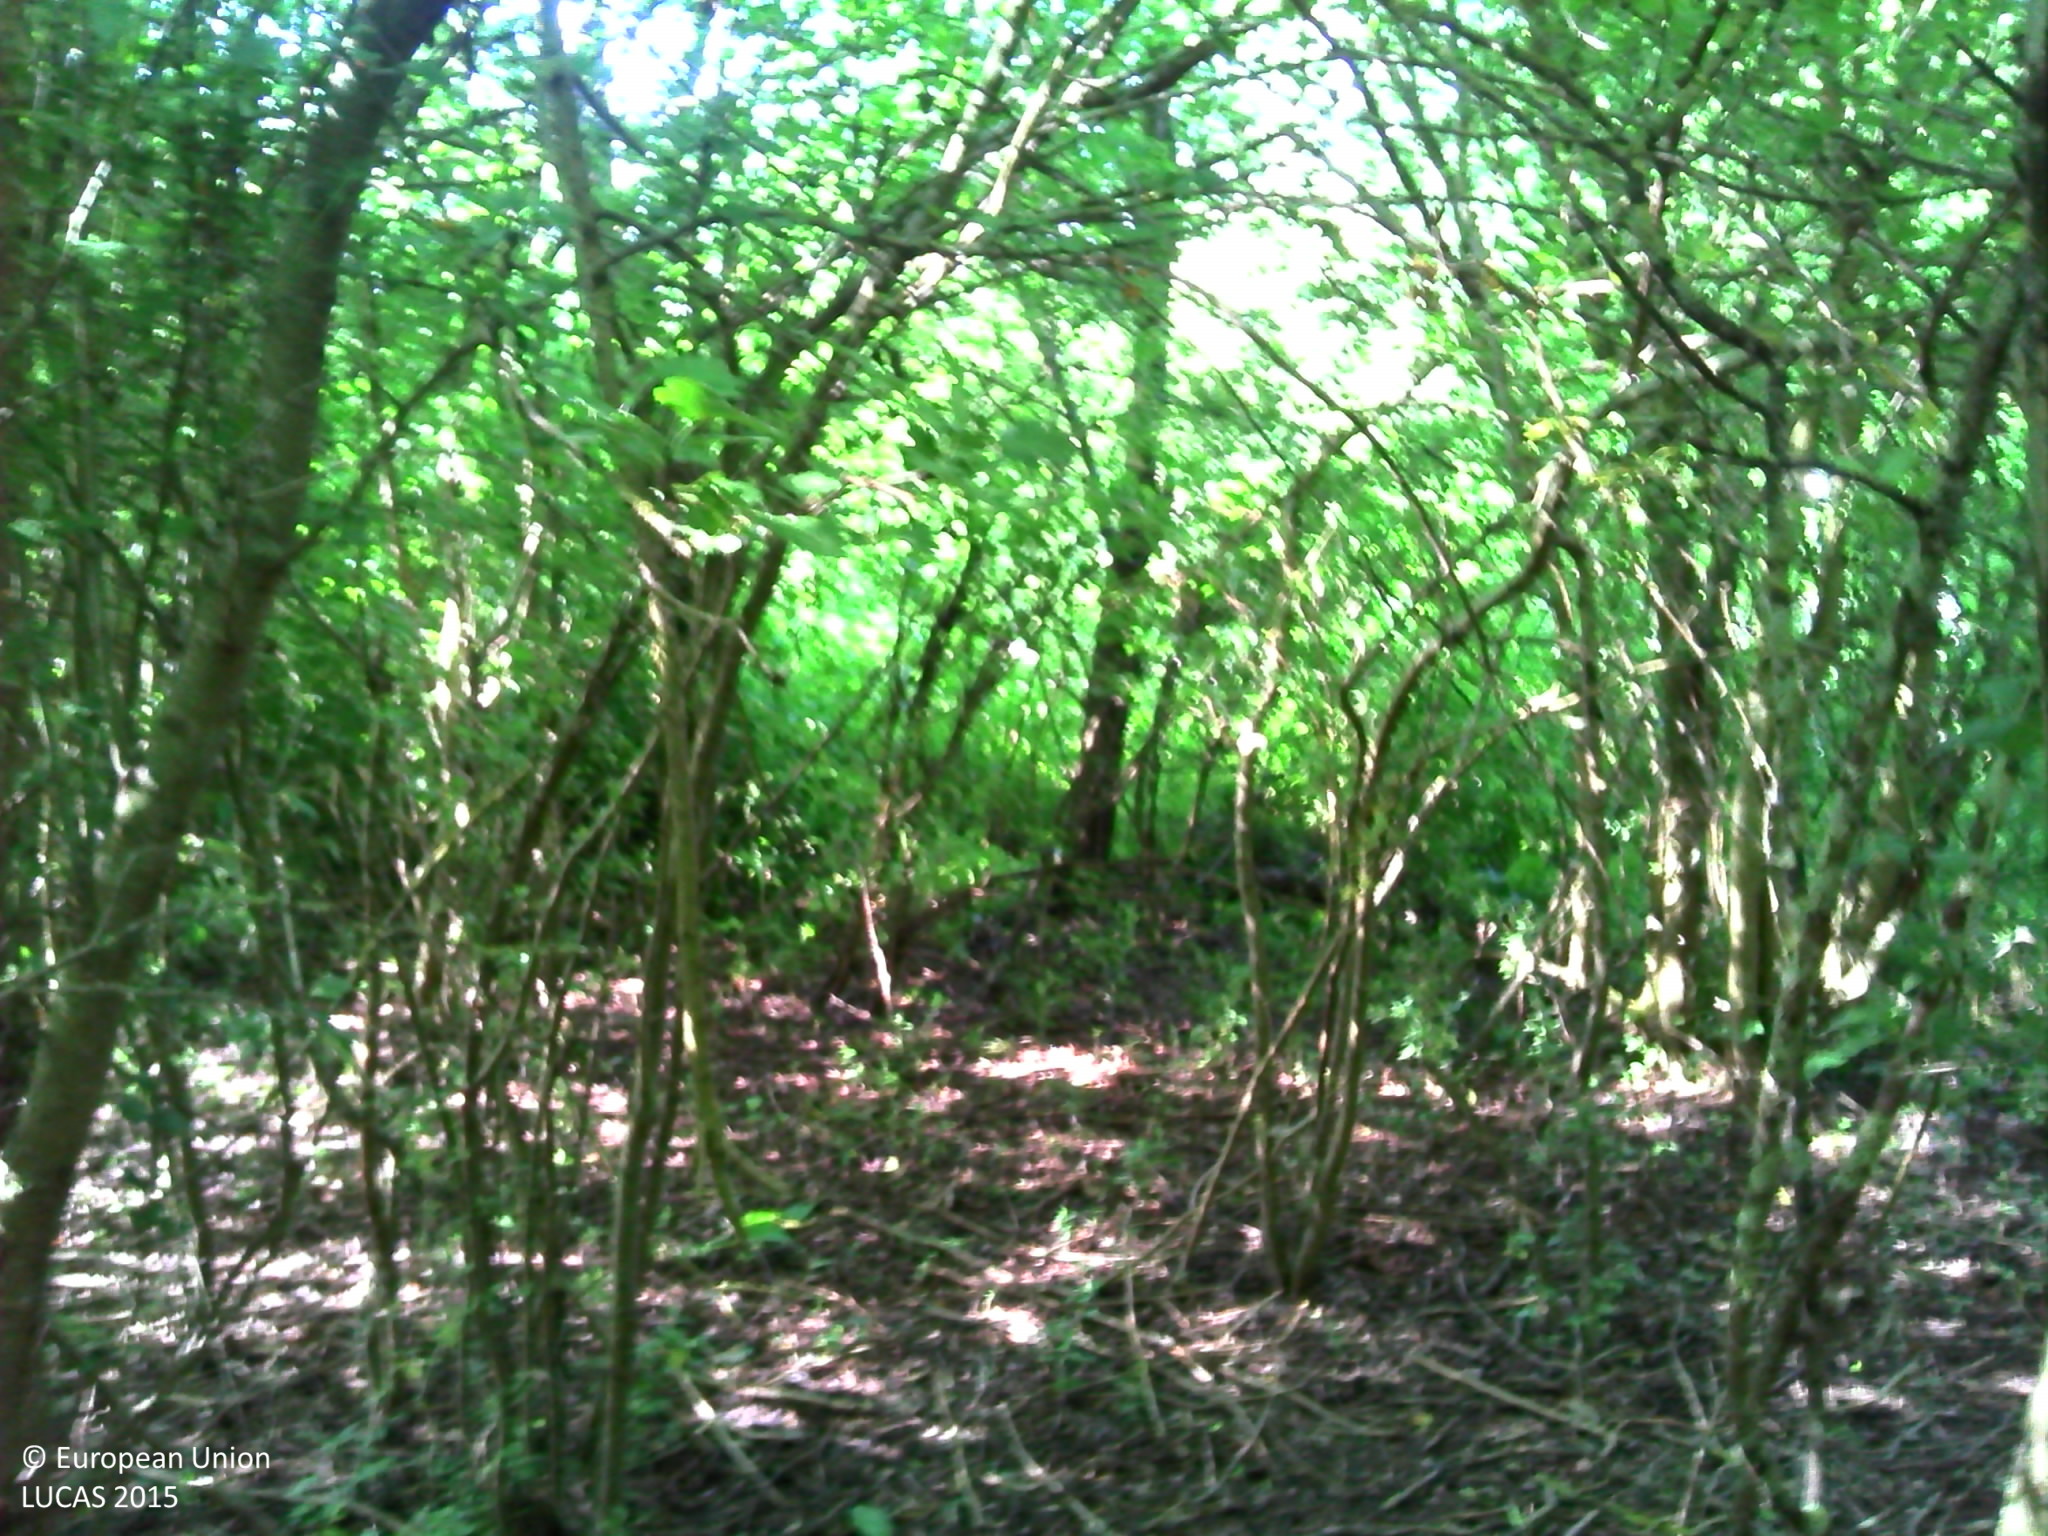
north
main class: Woodland
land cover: Broadleaved woodland
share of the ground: > 75 %
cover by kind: broadleaved forest trees 100 %
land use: Forestry
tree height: > 5 m
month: June
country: FR
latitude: 46.3120
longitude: -0.7937
